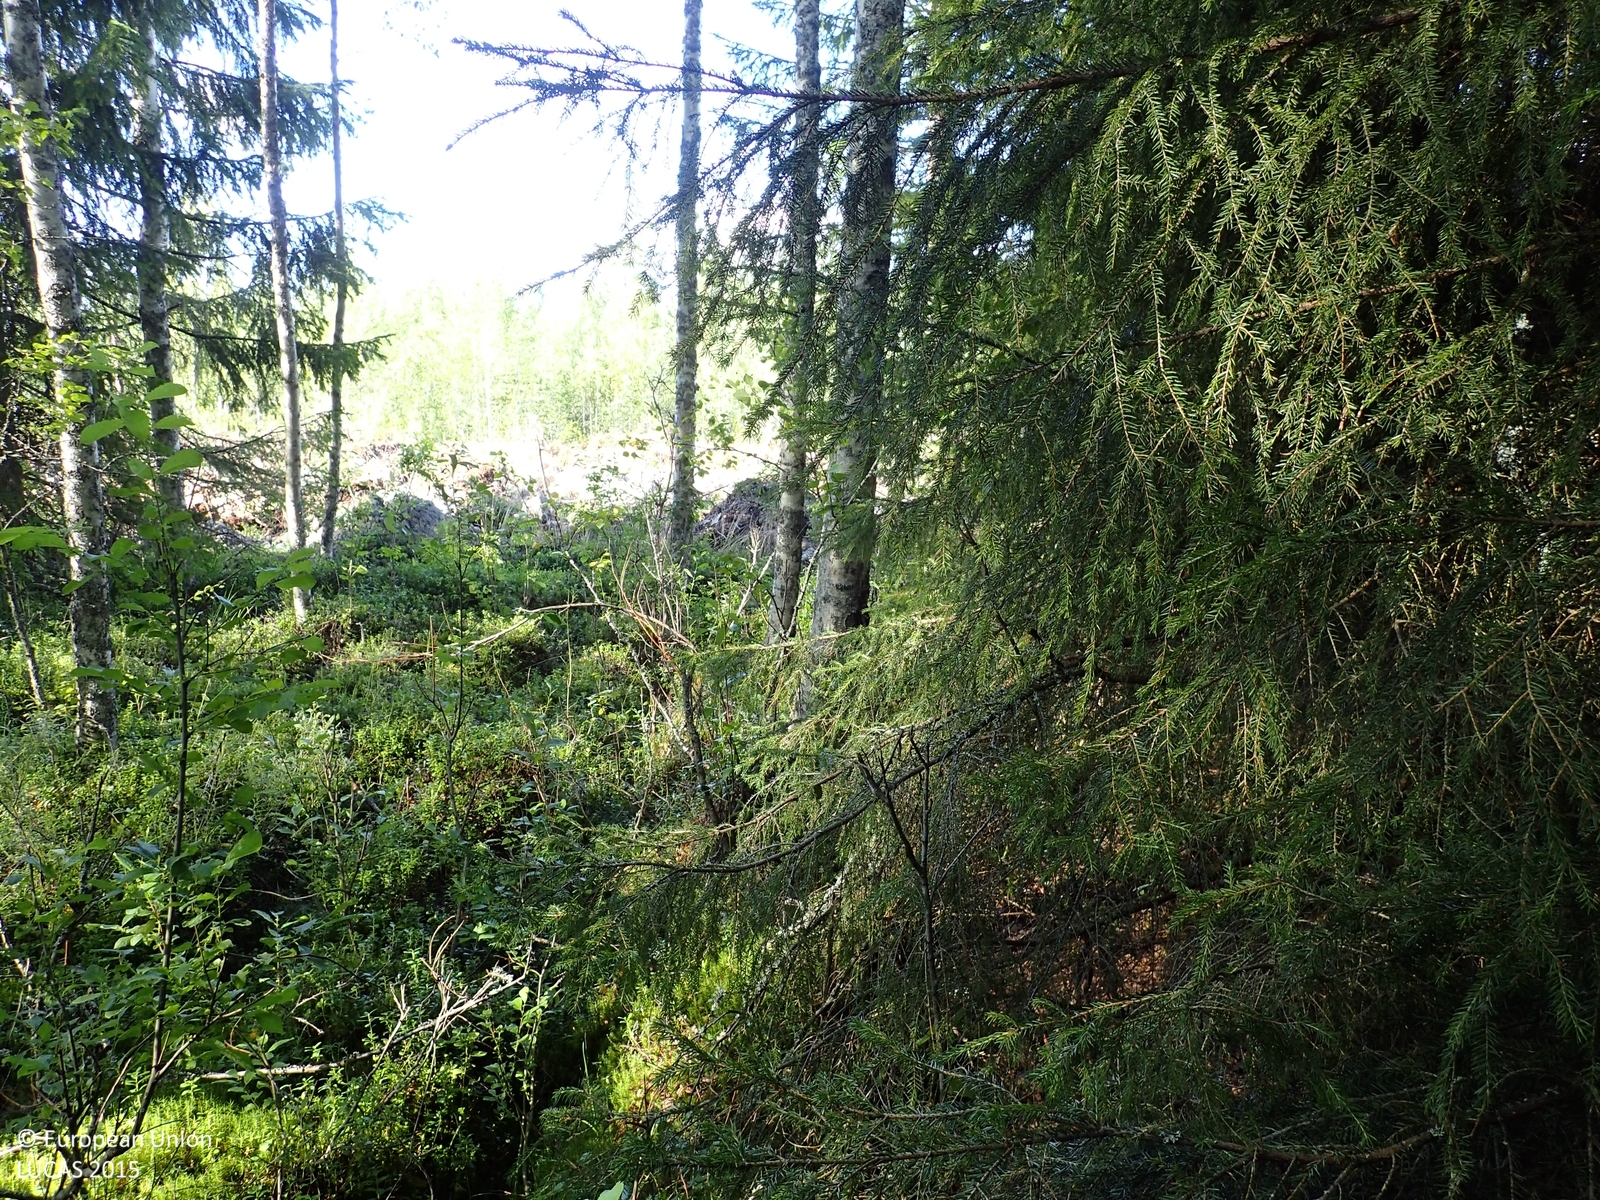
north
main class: Woodland
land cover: Spruce dominated mixed woodland
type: boreal forest
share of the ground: > 75 %
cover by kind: coniferous forest trees 50 %, broadleaved forest trees 30 %, shrubs 10 %, lichens and mosses 10 %
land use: Forestry
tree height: > 5 m
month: August
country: FI
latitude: 62.6450
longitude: 21.9666
